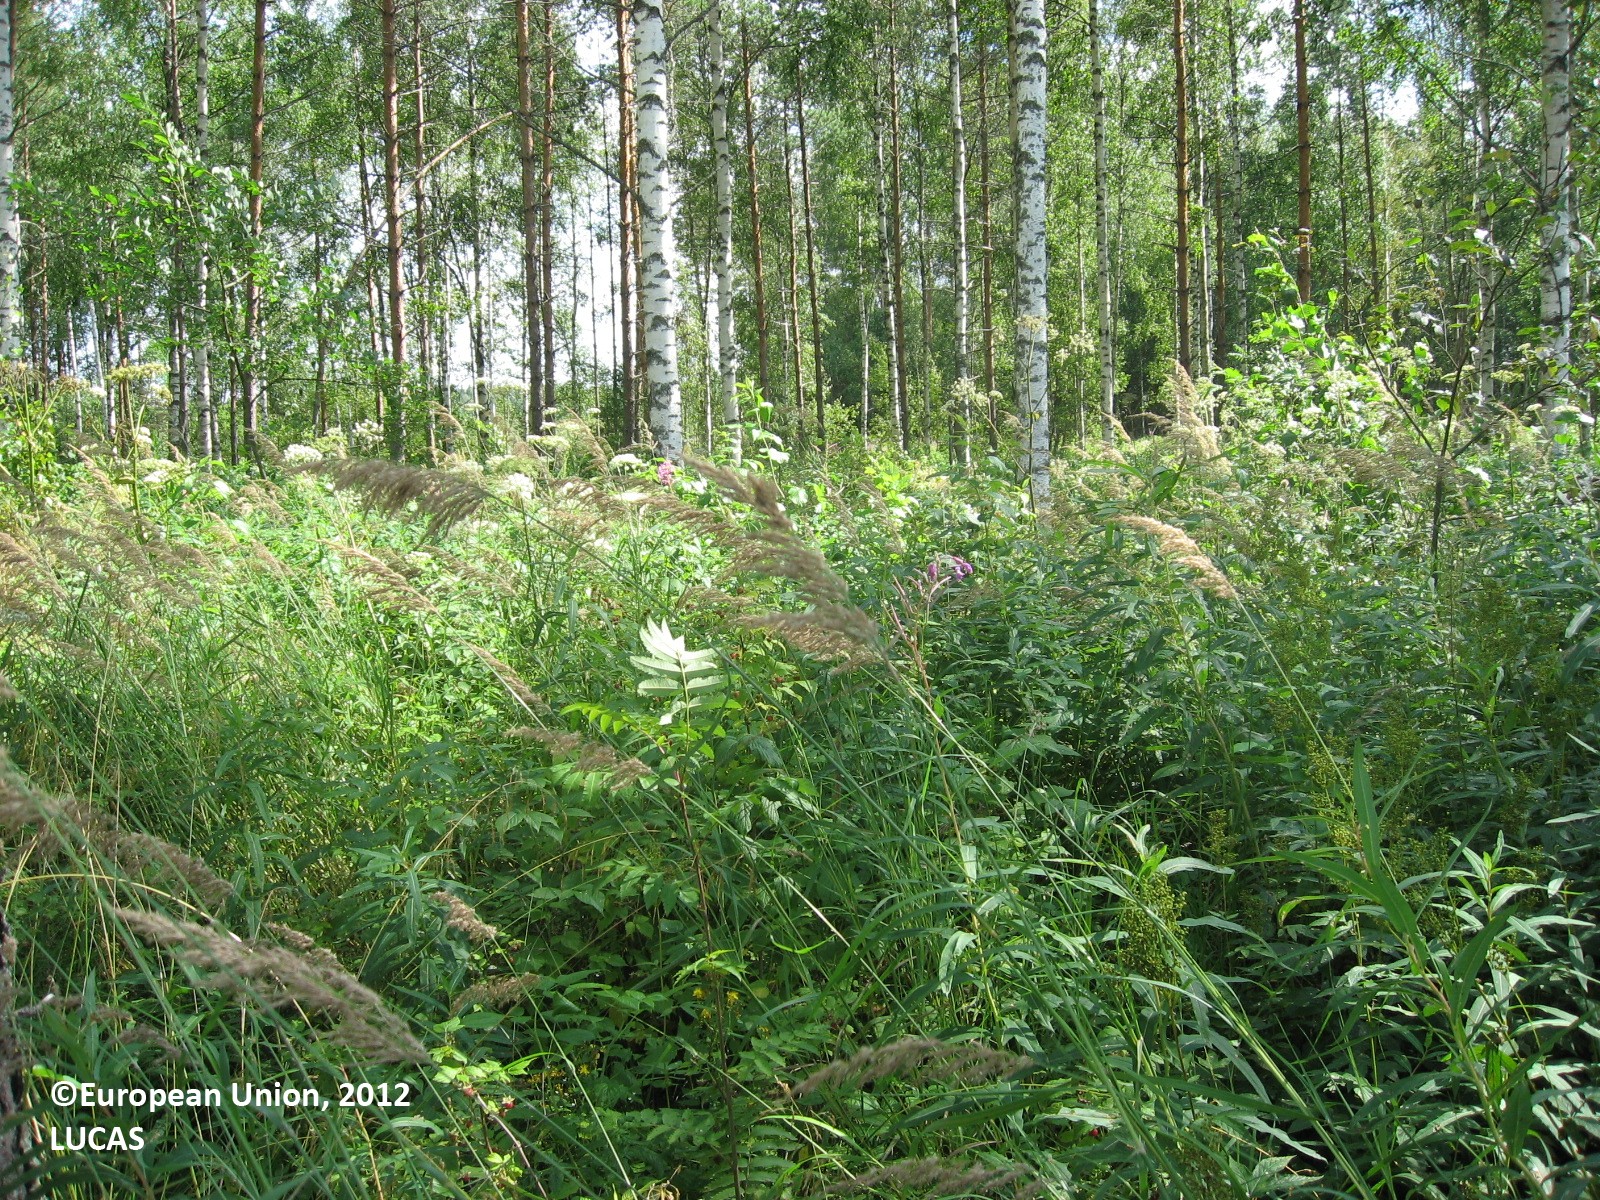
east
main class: Woodland
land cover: Broadleaved woodland
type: boreal forest
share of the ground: > 75 %
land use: Forestry
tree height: > 5 m
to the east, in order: Broadleaved woodland; Other mixed woodland; Ditches and canals; Other mixed woodland; Rivers and streams; Other bare soil; Rivers and streams; Pine dominated coniferous woodland
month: August
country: FI
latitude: 61.5416
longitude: 26.0302
